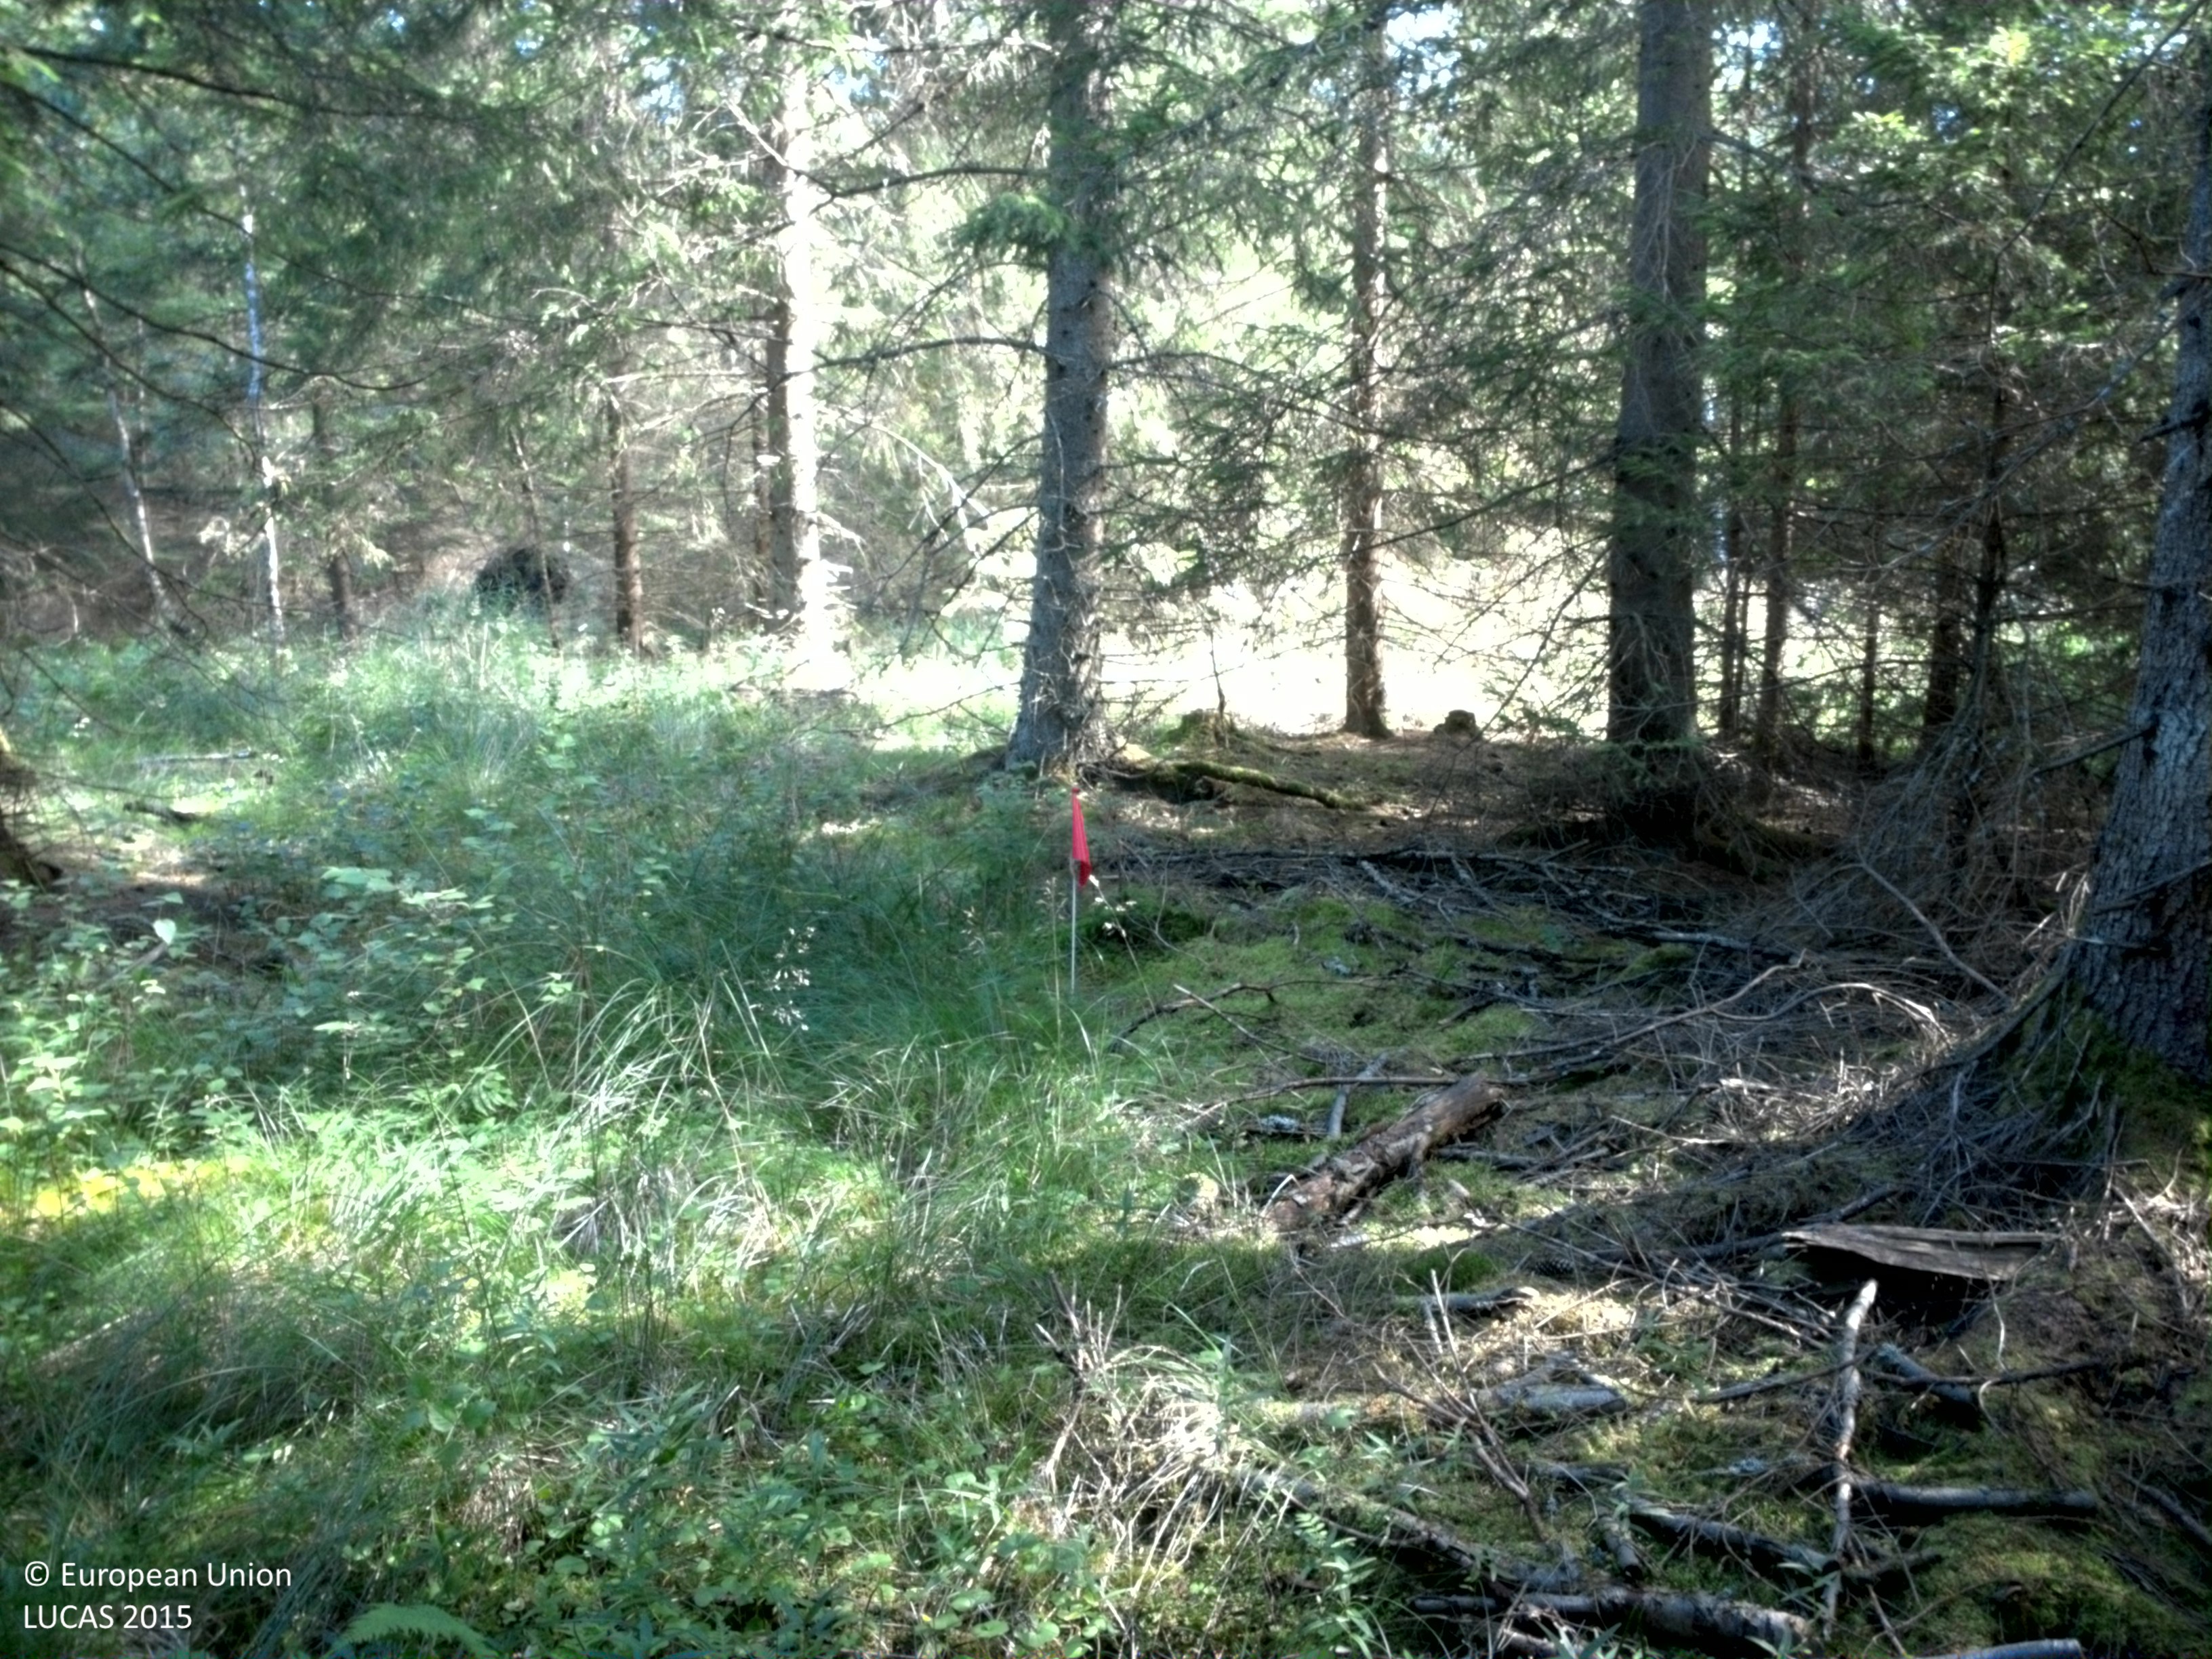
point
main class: Woodland
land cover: Spruce dominated coniferous woodland
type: boreal forest
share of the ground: 50 - 75 %
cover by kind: coniferous forest trees 70 %, lichens and mosses 25 %, herbaceous plants 5 %
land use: Forestry
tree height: > 5 m
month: August
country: SE
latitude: 58.2147
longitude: 13.3137
